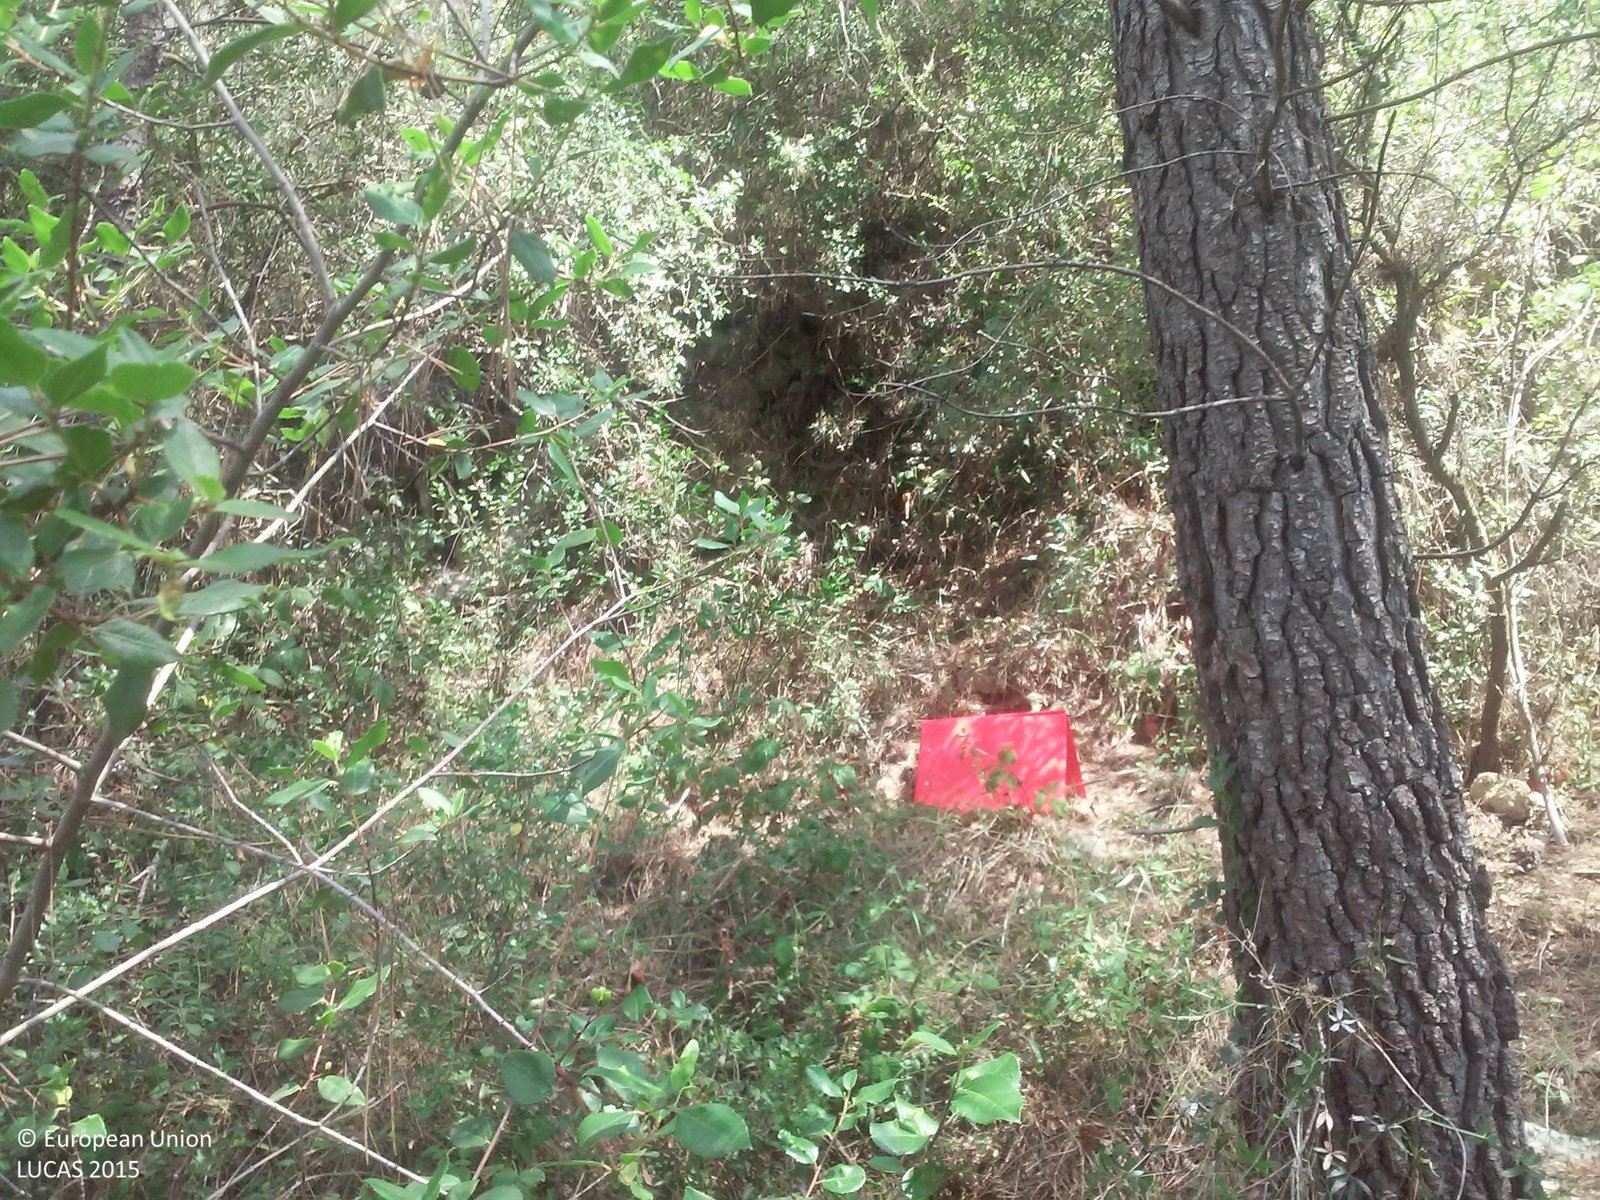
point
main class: Woodland
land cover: Pine dominated coniferous woodland
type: coniferous forest of the mediterranean region
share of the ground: > 75 %
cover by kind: coniferous forest trees 80 %, herbaceous plants 10 %, broadleaved forest trees 5 %, shrubs 5 %
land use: Semi-natural and natural areas not in use
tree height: > 5 m
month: July
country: ES
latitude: 41.1494
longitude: 1.2597
